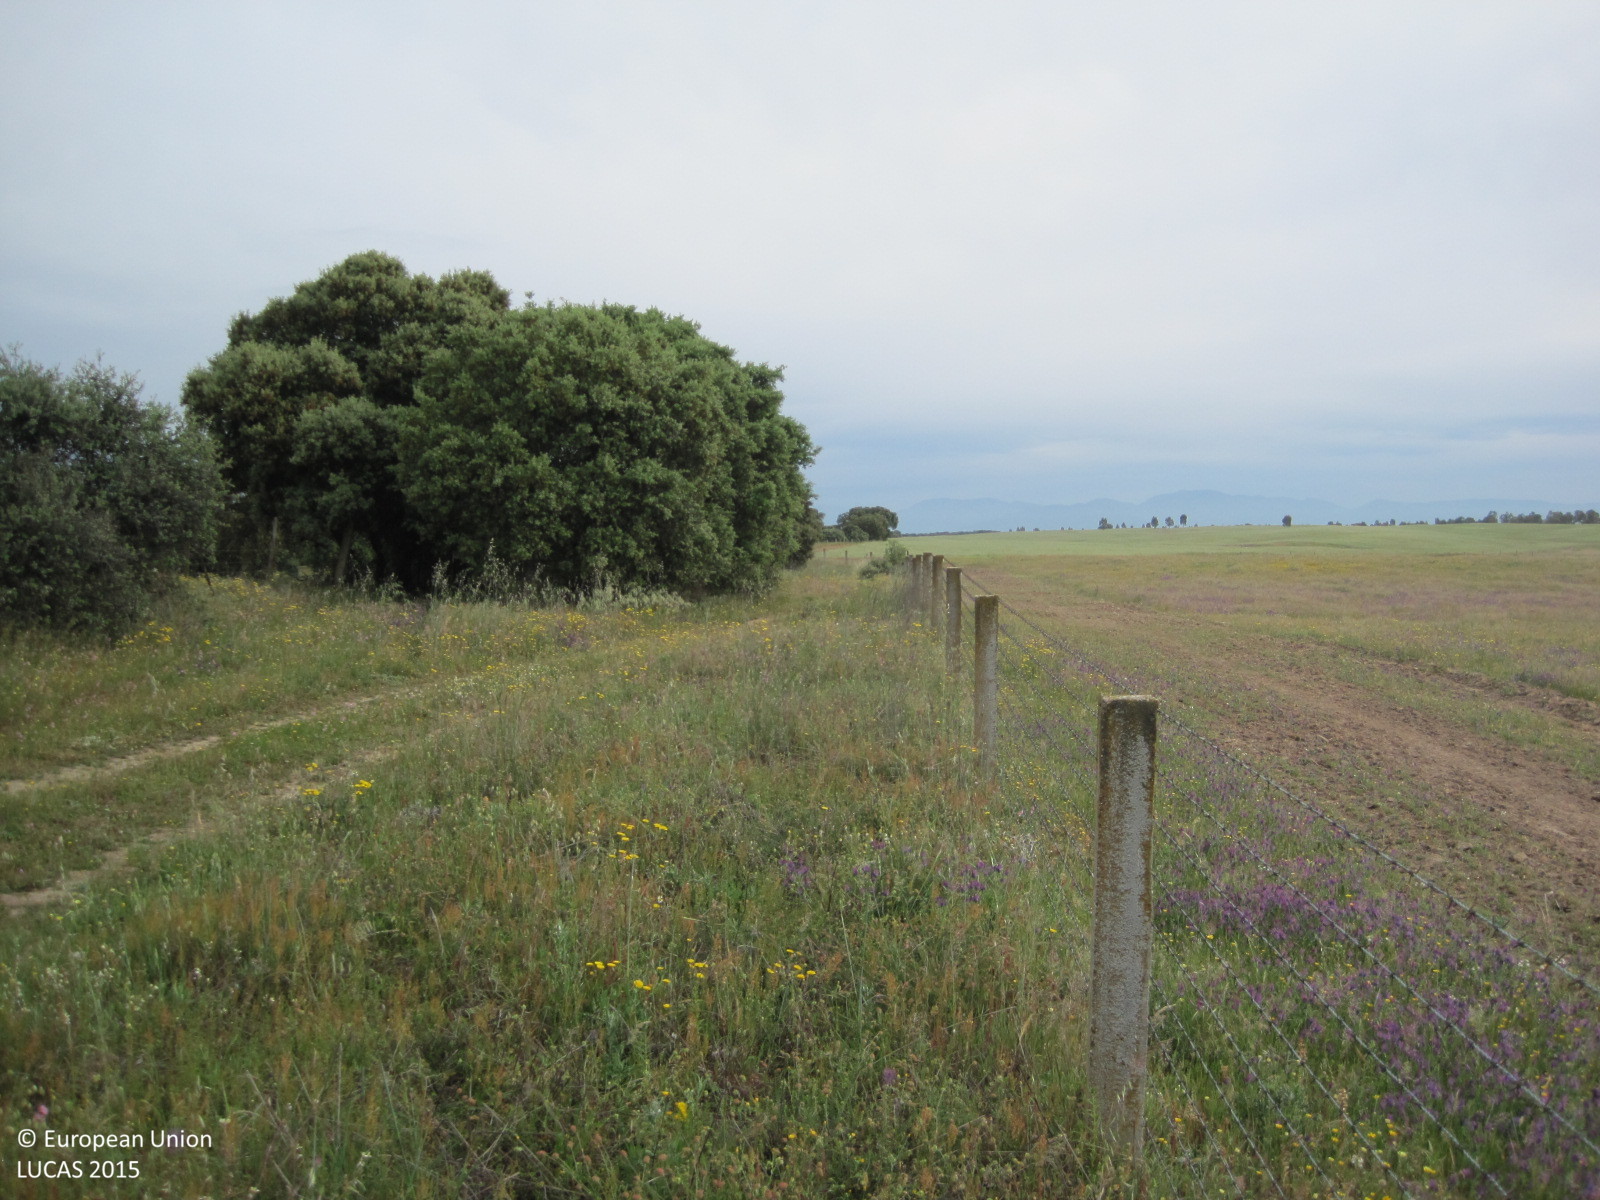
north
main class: Grassland
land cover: Grassland without tree/shrub cover
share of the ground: > 75 %
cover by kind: herbaceous plants 100 %
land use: Agriculture (excluding fallow land and kitchen gardens)
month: May
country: ES
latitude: 39.8597
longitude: -5.1186
